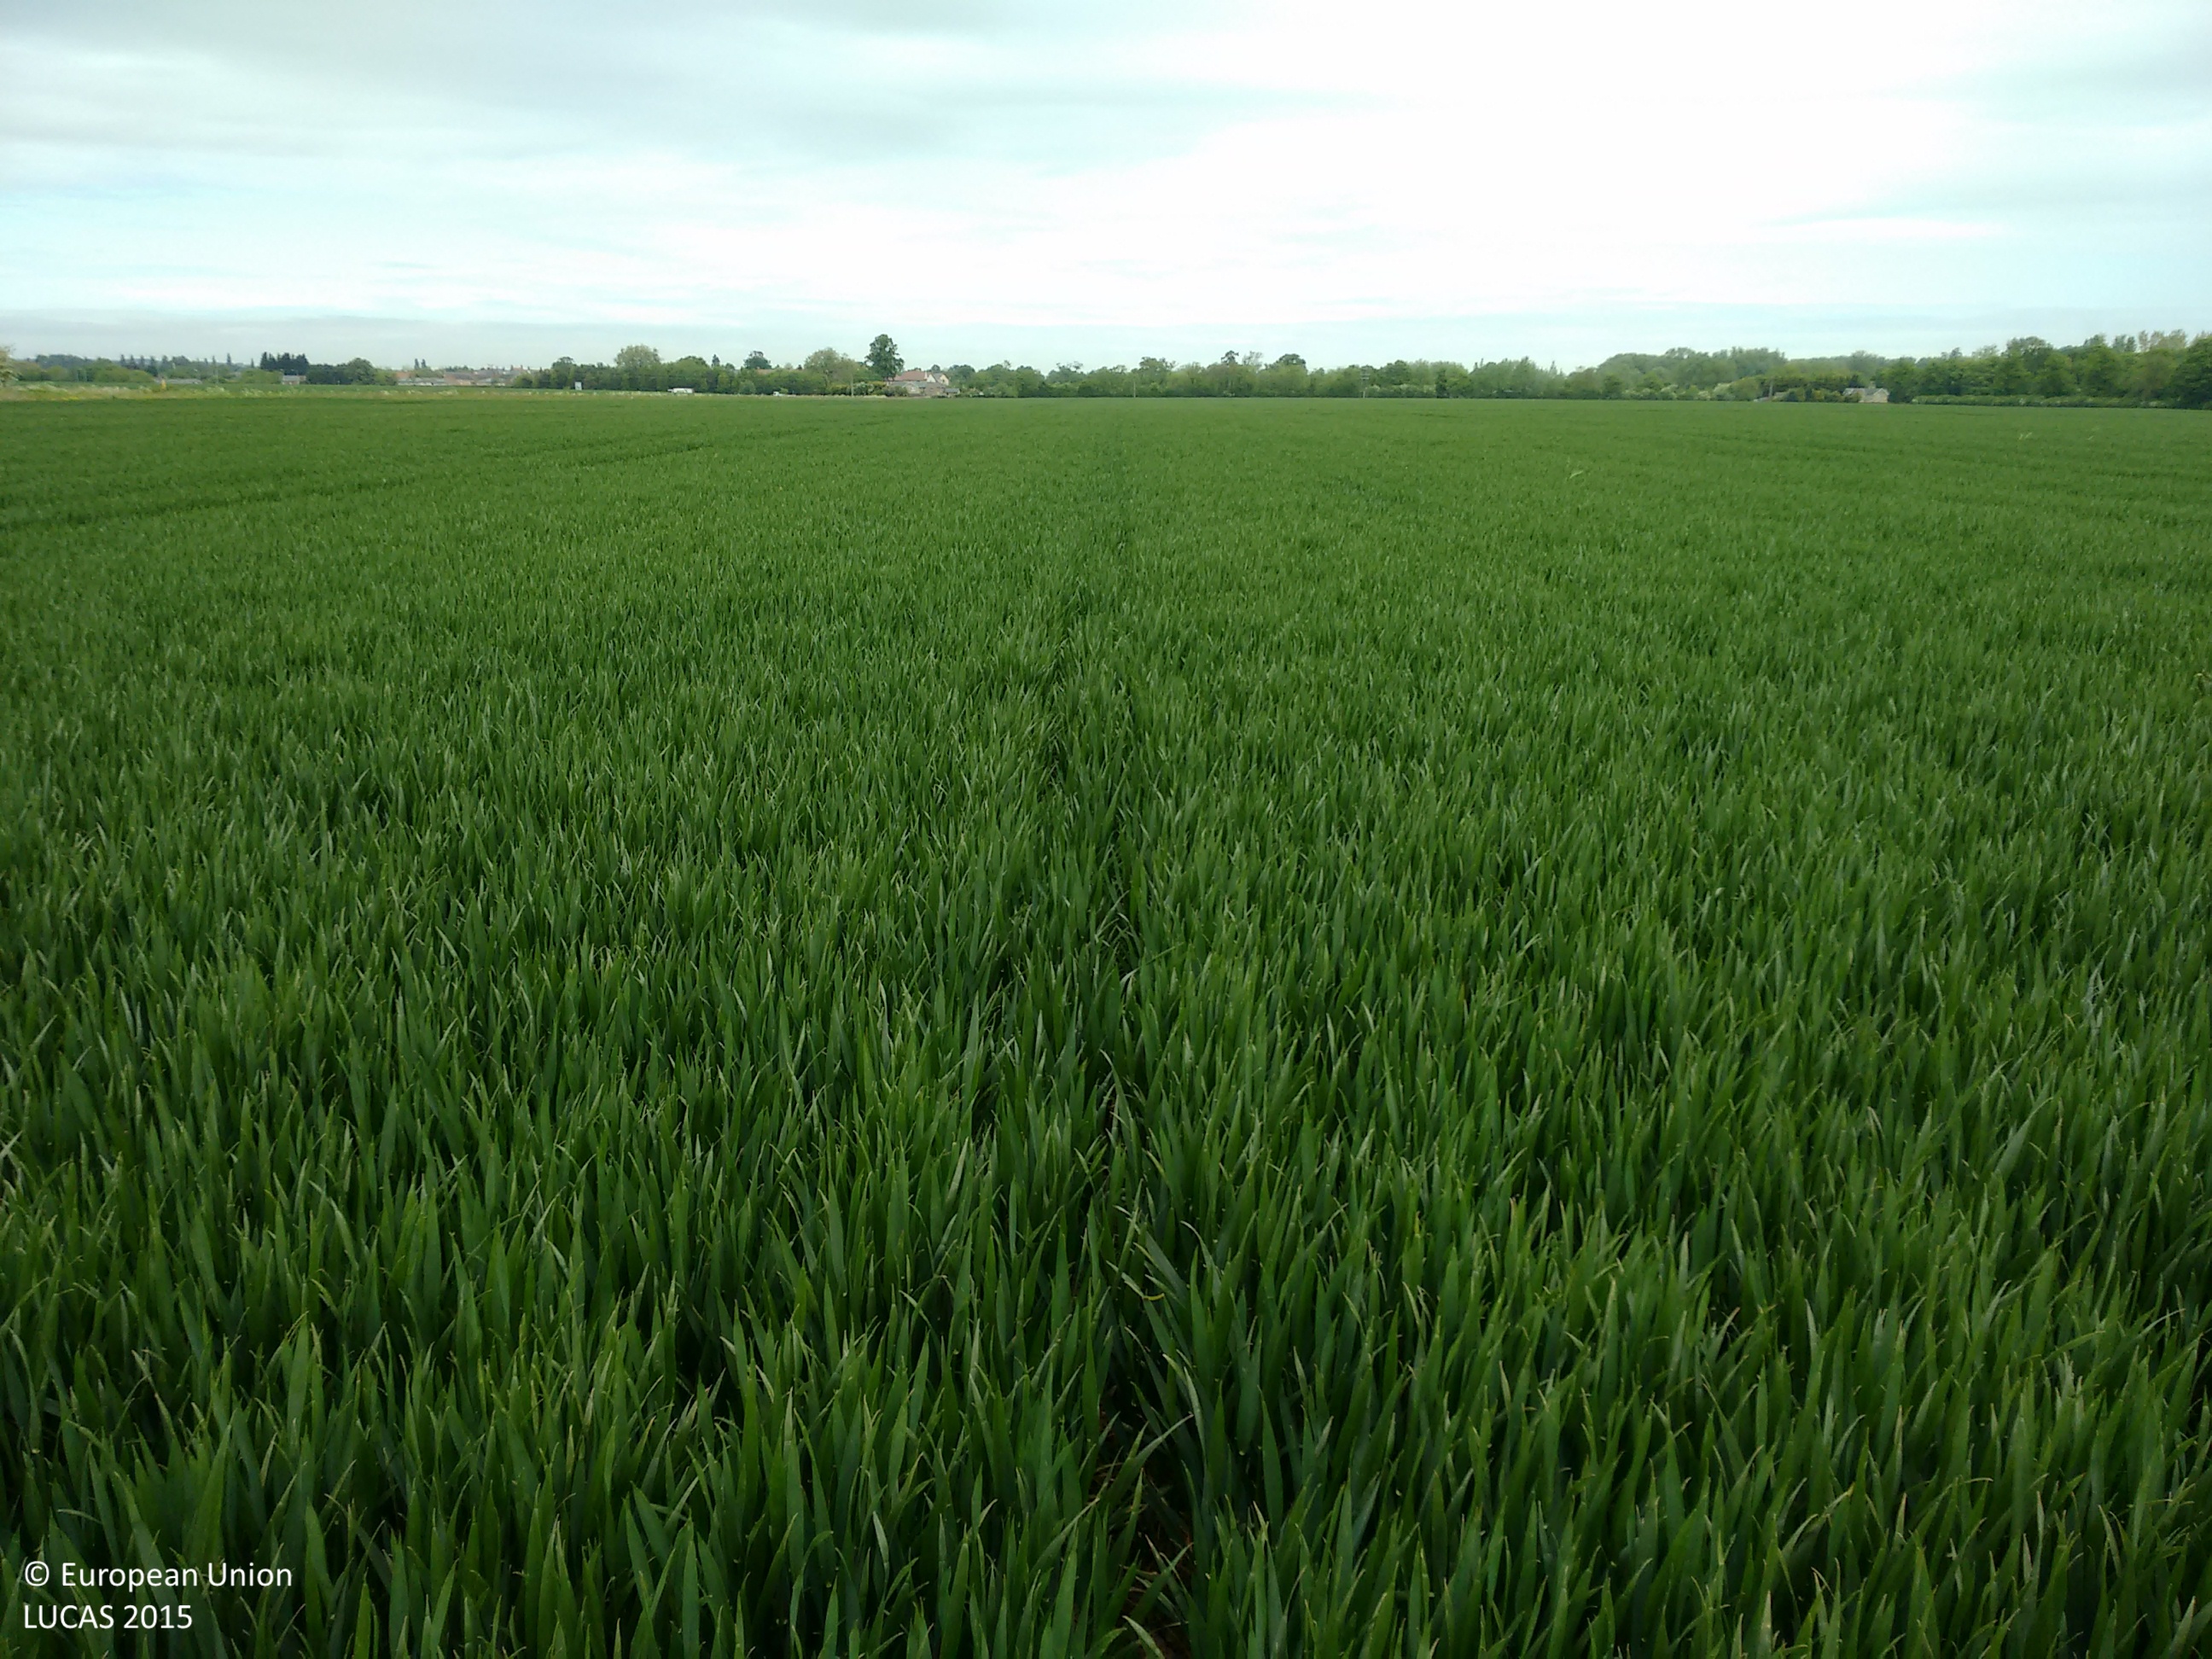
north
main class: Cropland
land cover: Barley
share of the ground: > 75 %
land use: Agriculture (excluding fallow land and kitchen gardens)
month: May
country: GB
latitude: 52.0206
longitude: -0.2803
